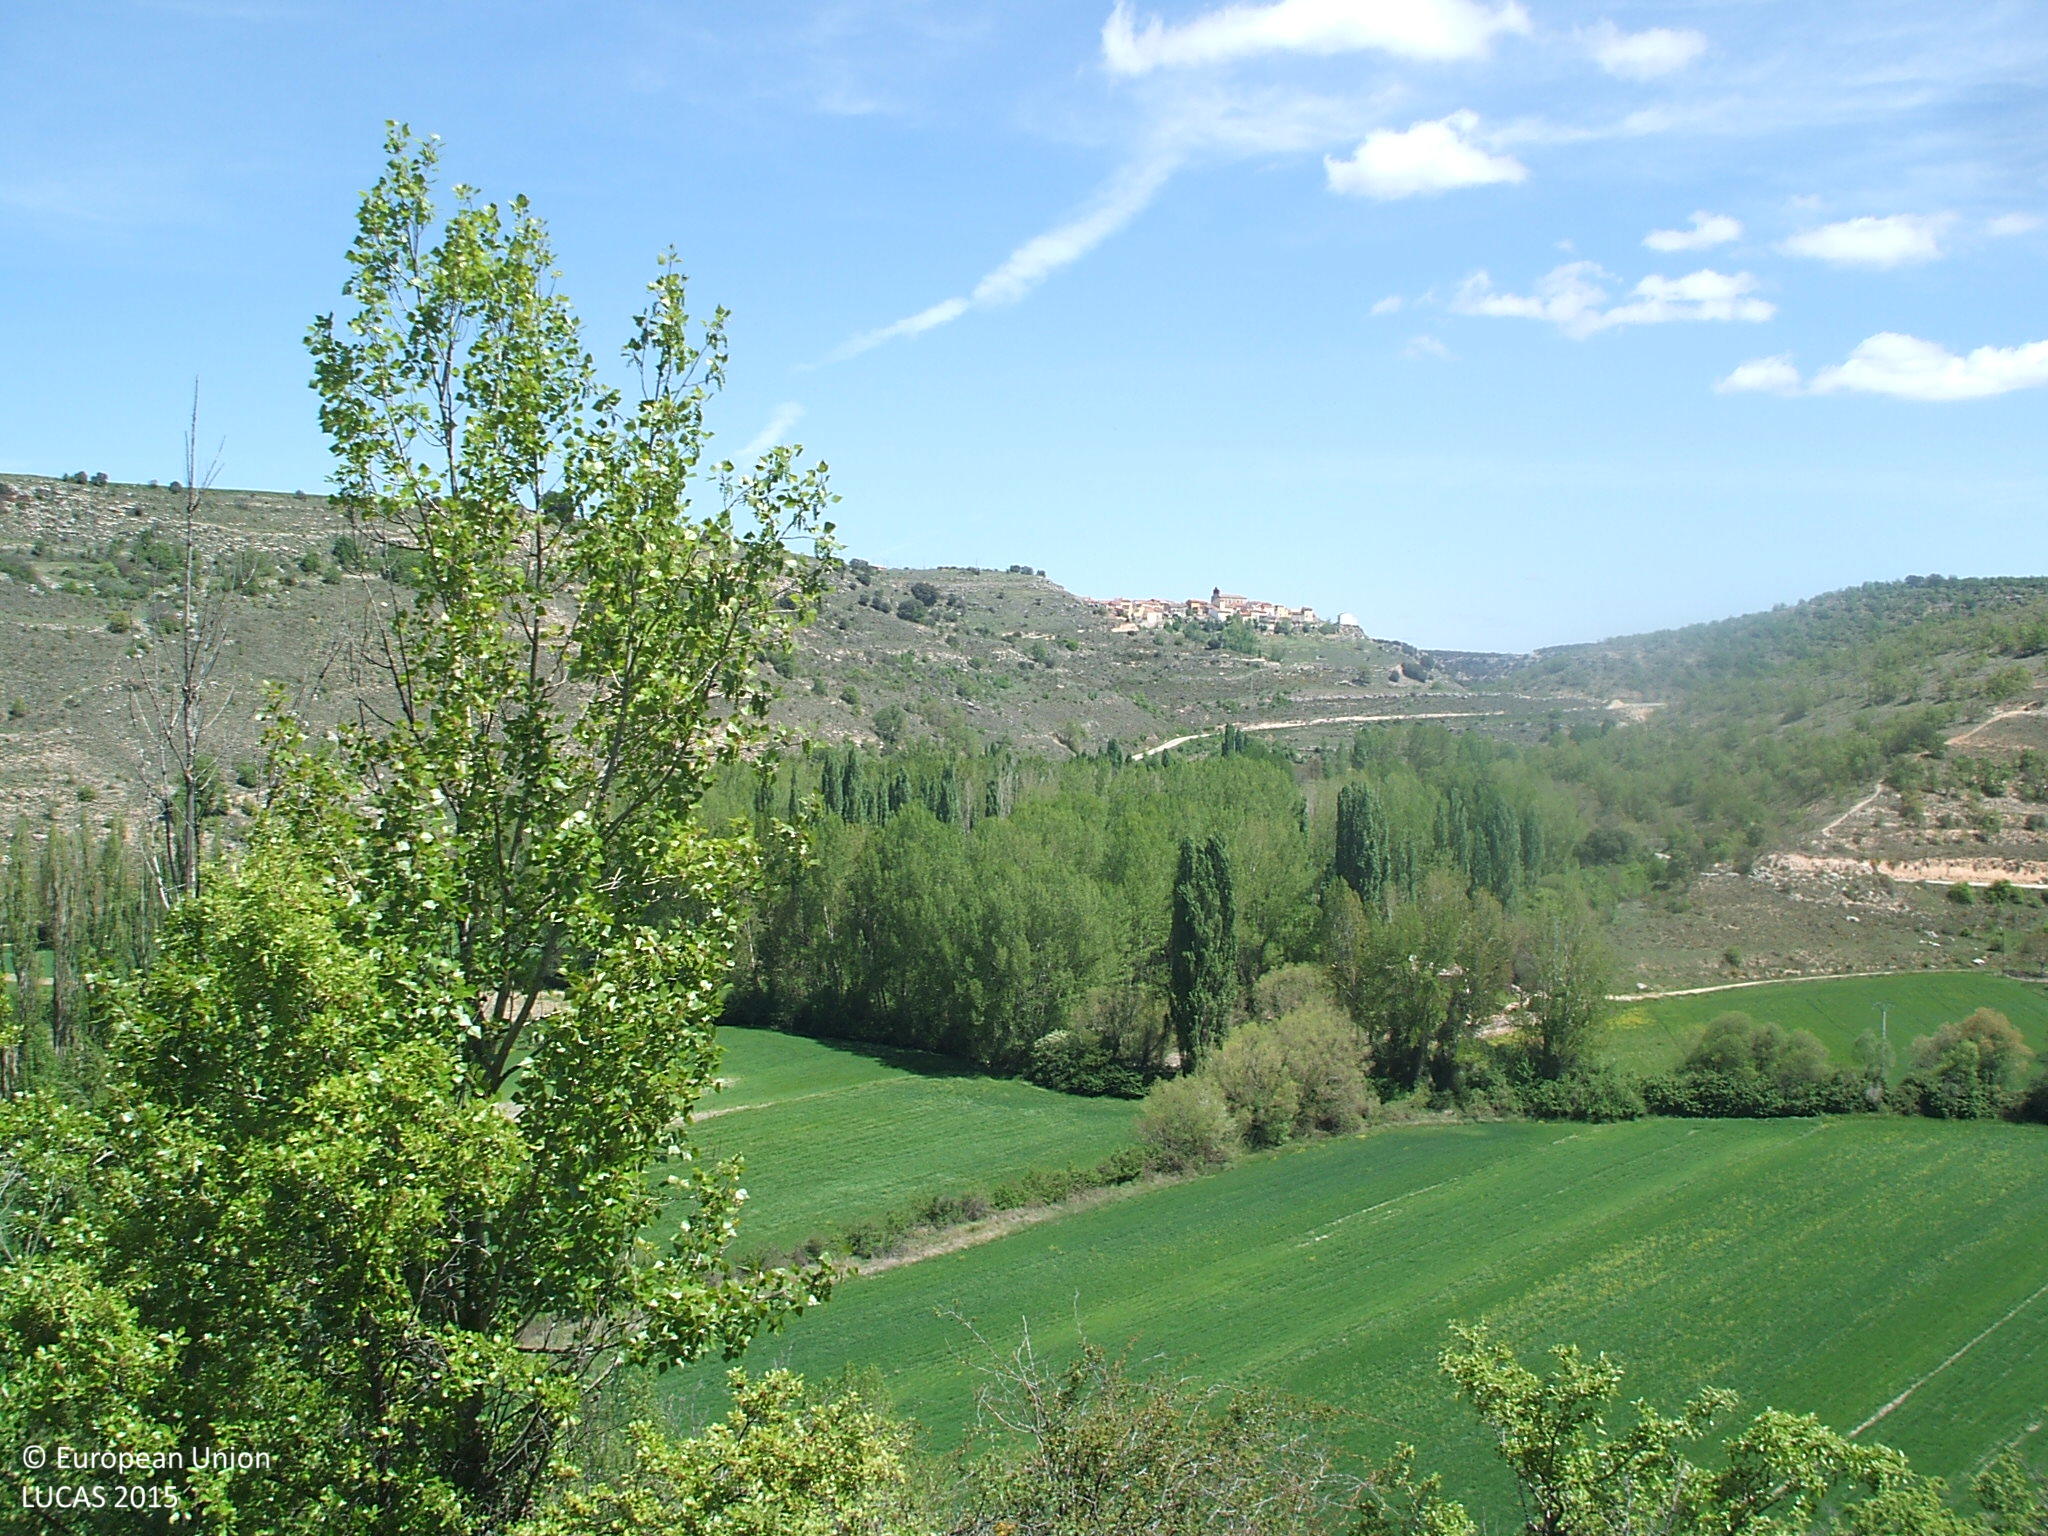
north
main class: Shrubland
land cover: Shrubland with sparse tree cover
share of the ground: > 75 %
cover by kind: shrubs 95 %, broadleaved forest trees 5 %
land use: Semi-natural and natural areas not in use
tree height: > 5 m
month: May
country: ES
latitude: 40.7403
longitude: -2.9519
